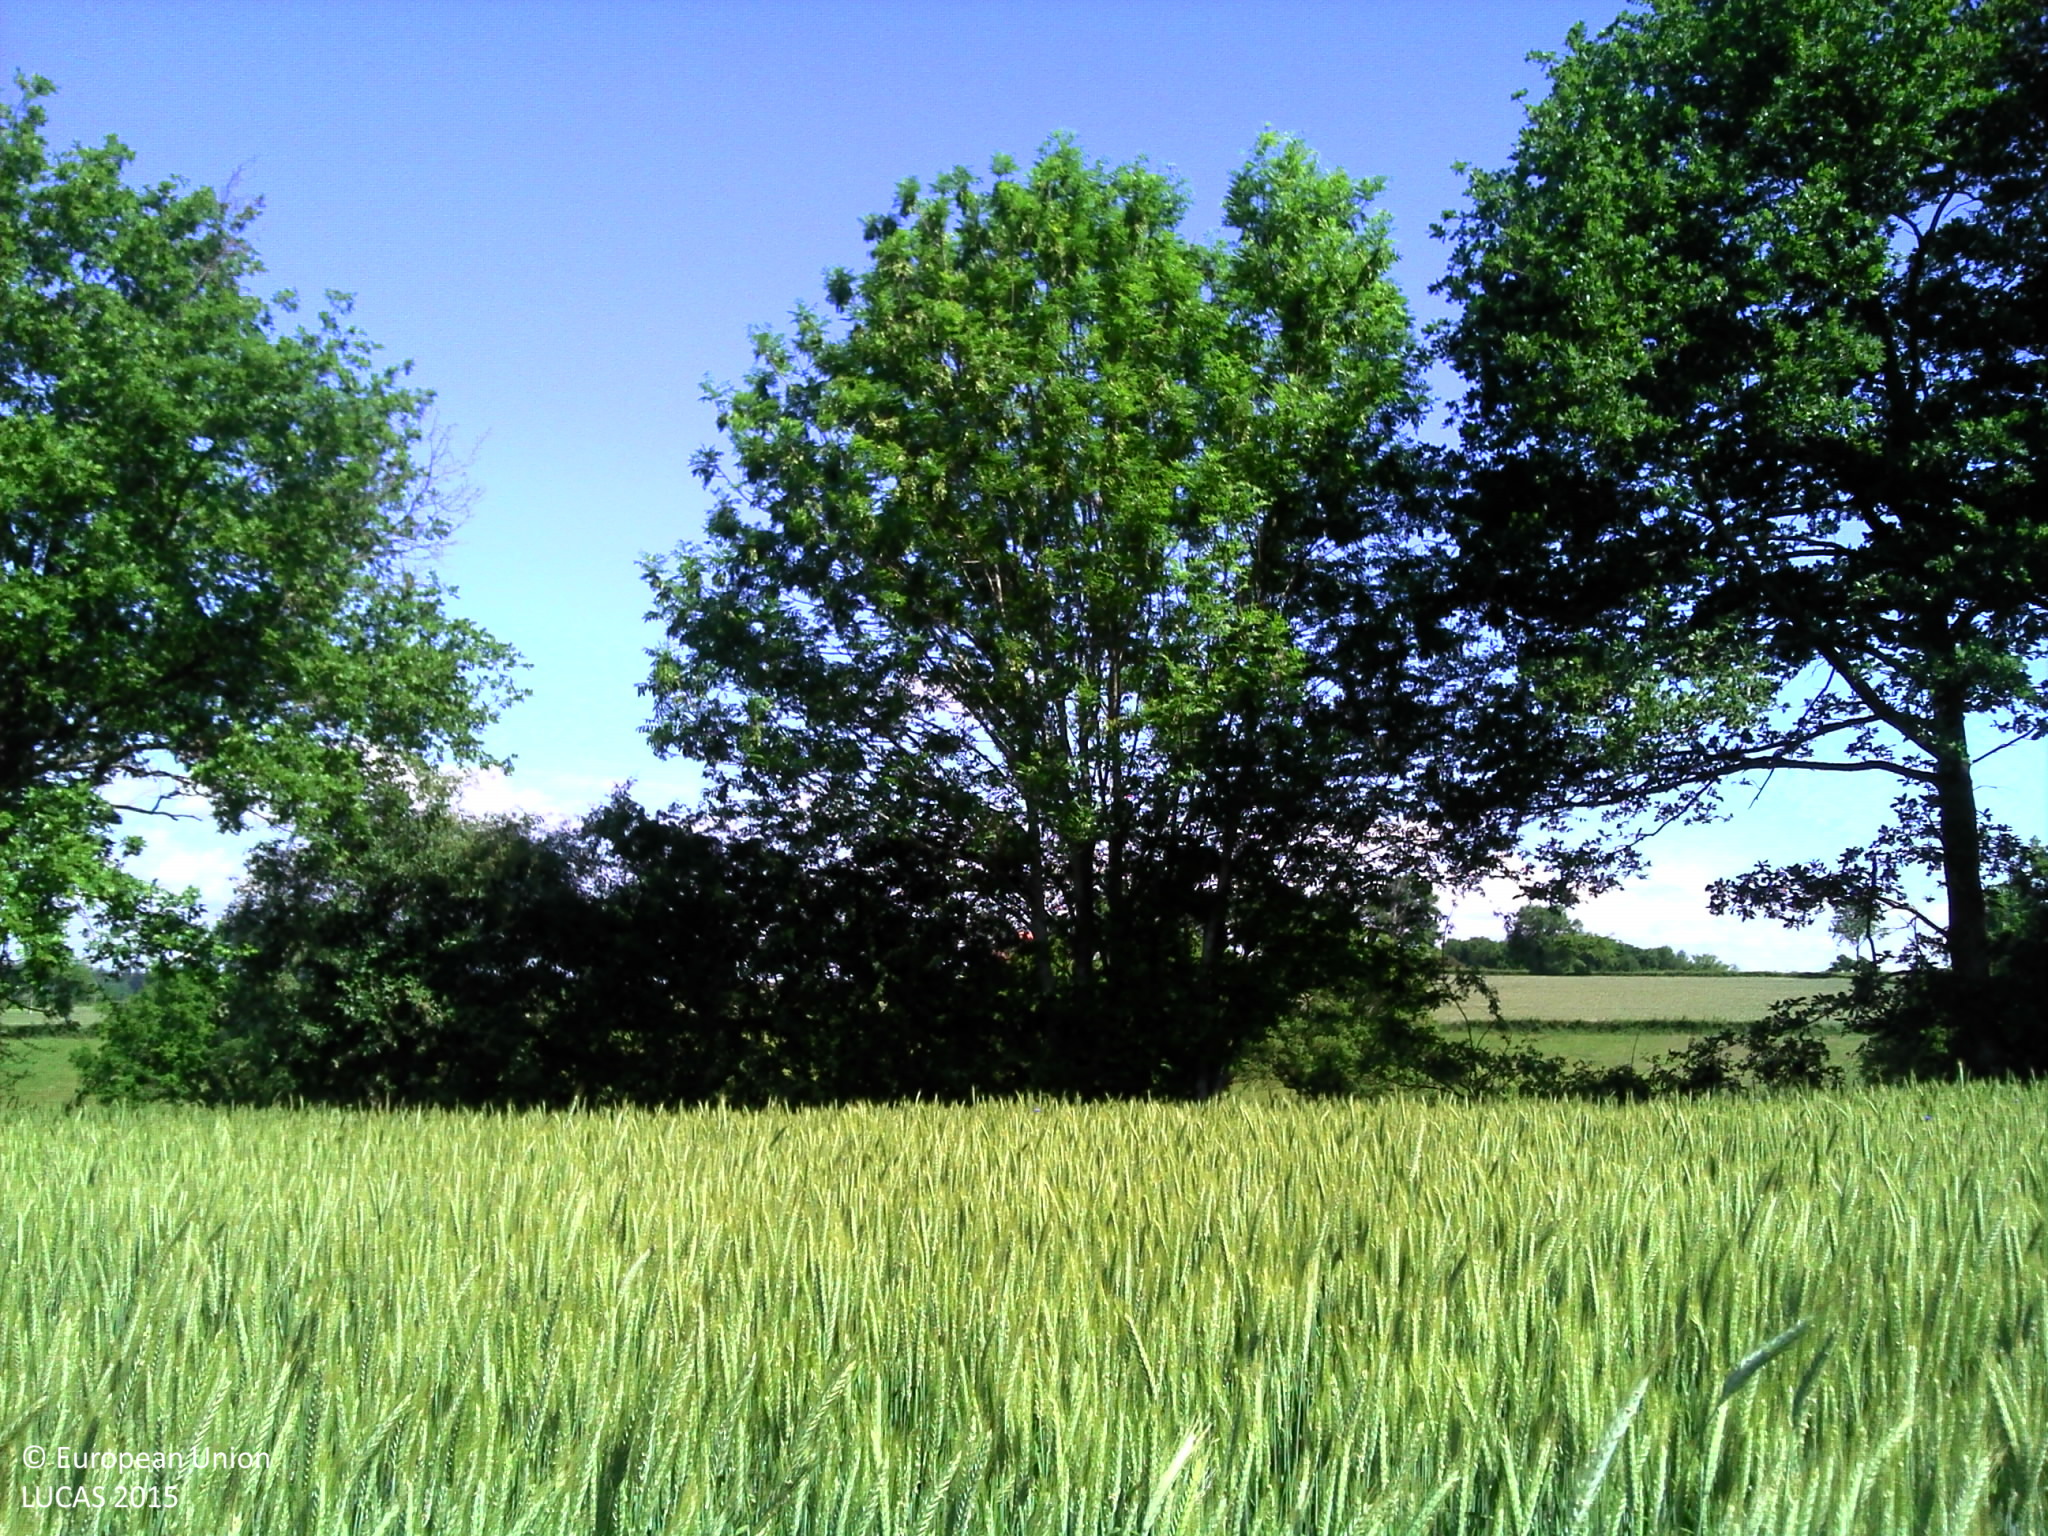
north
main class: Cropland
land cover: Rye
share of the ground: > 75 %
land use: Agriculture (excluding fallow land and kitchen gardens)
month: May
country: FR
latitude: 46.2691
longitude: 2.7696
